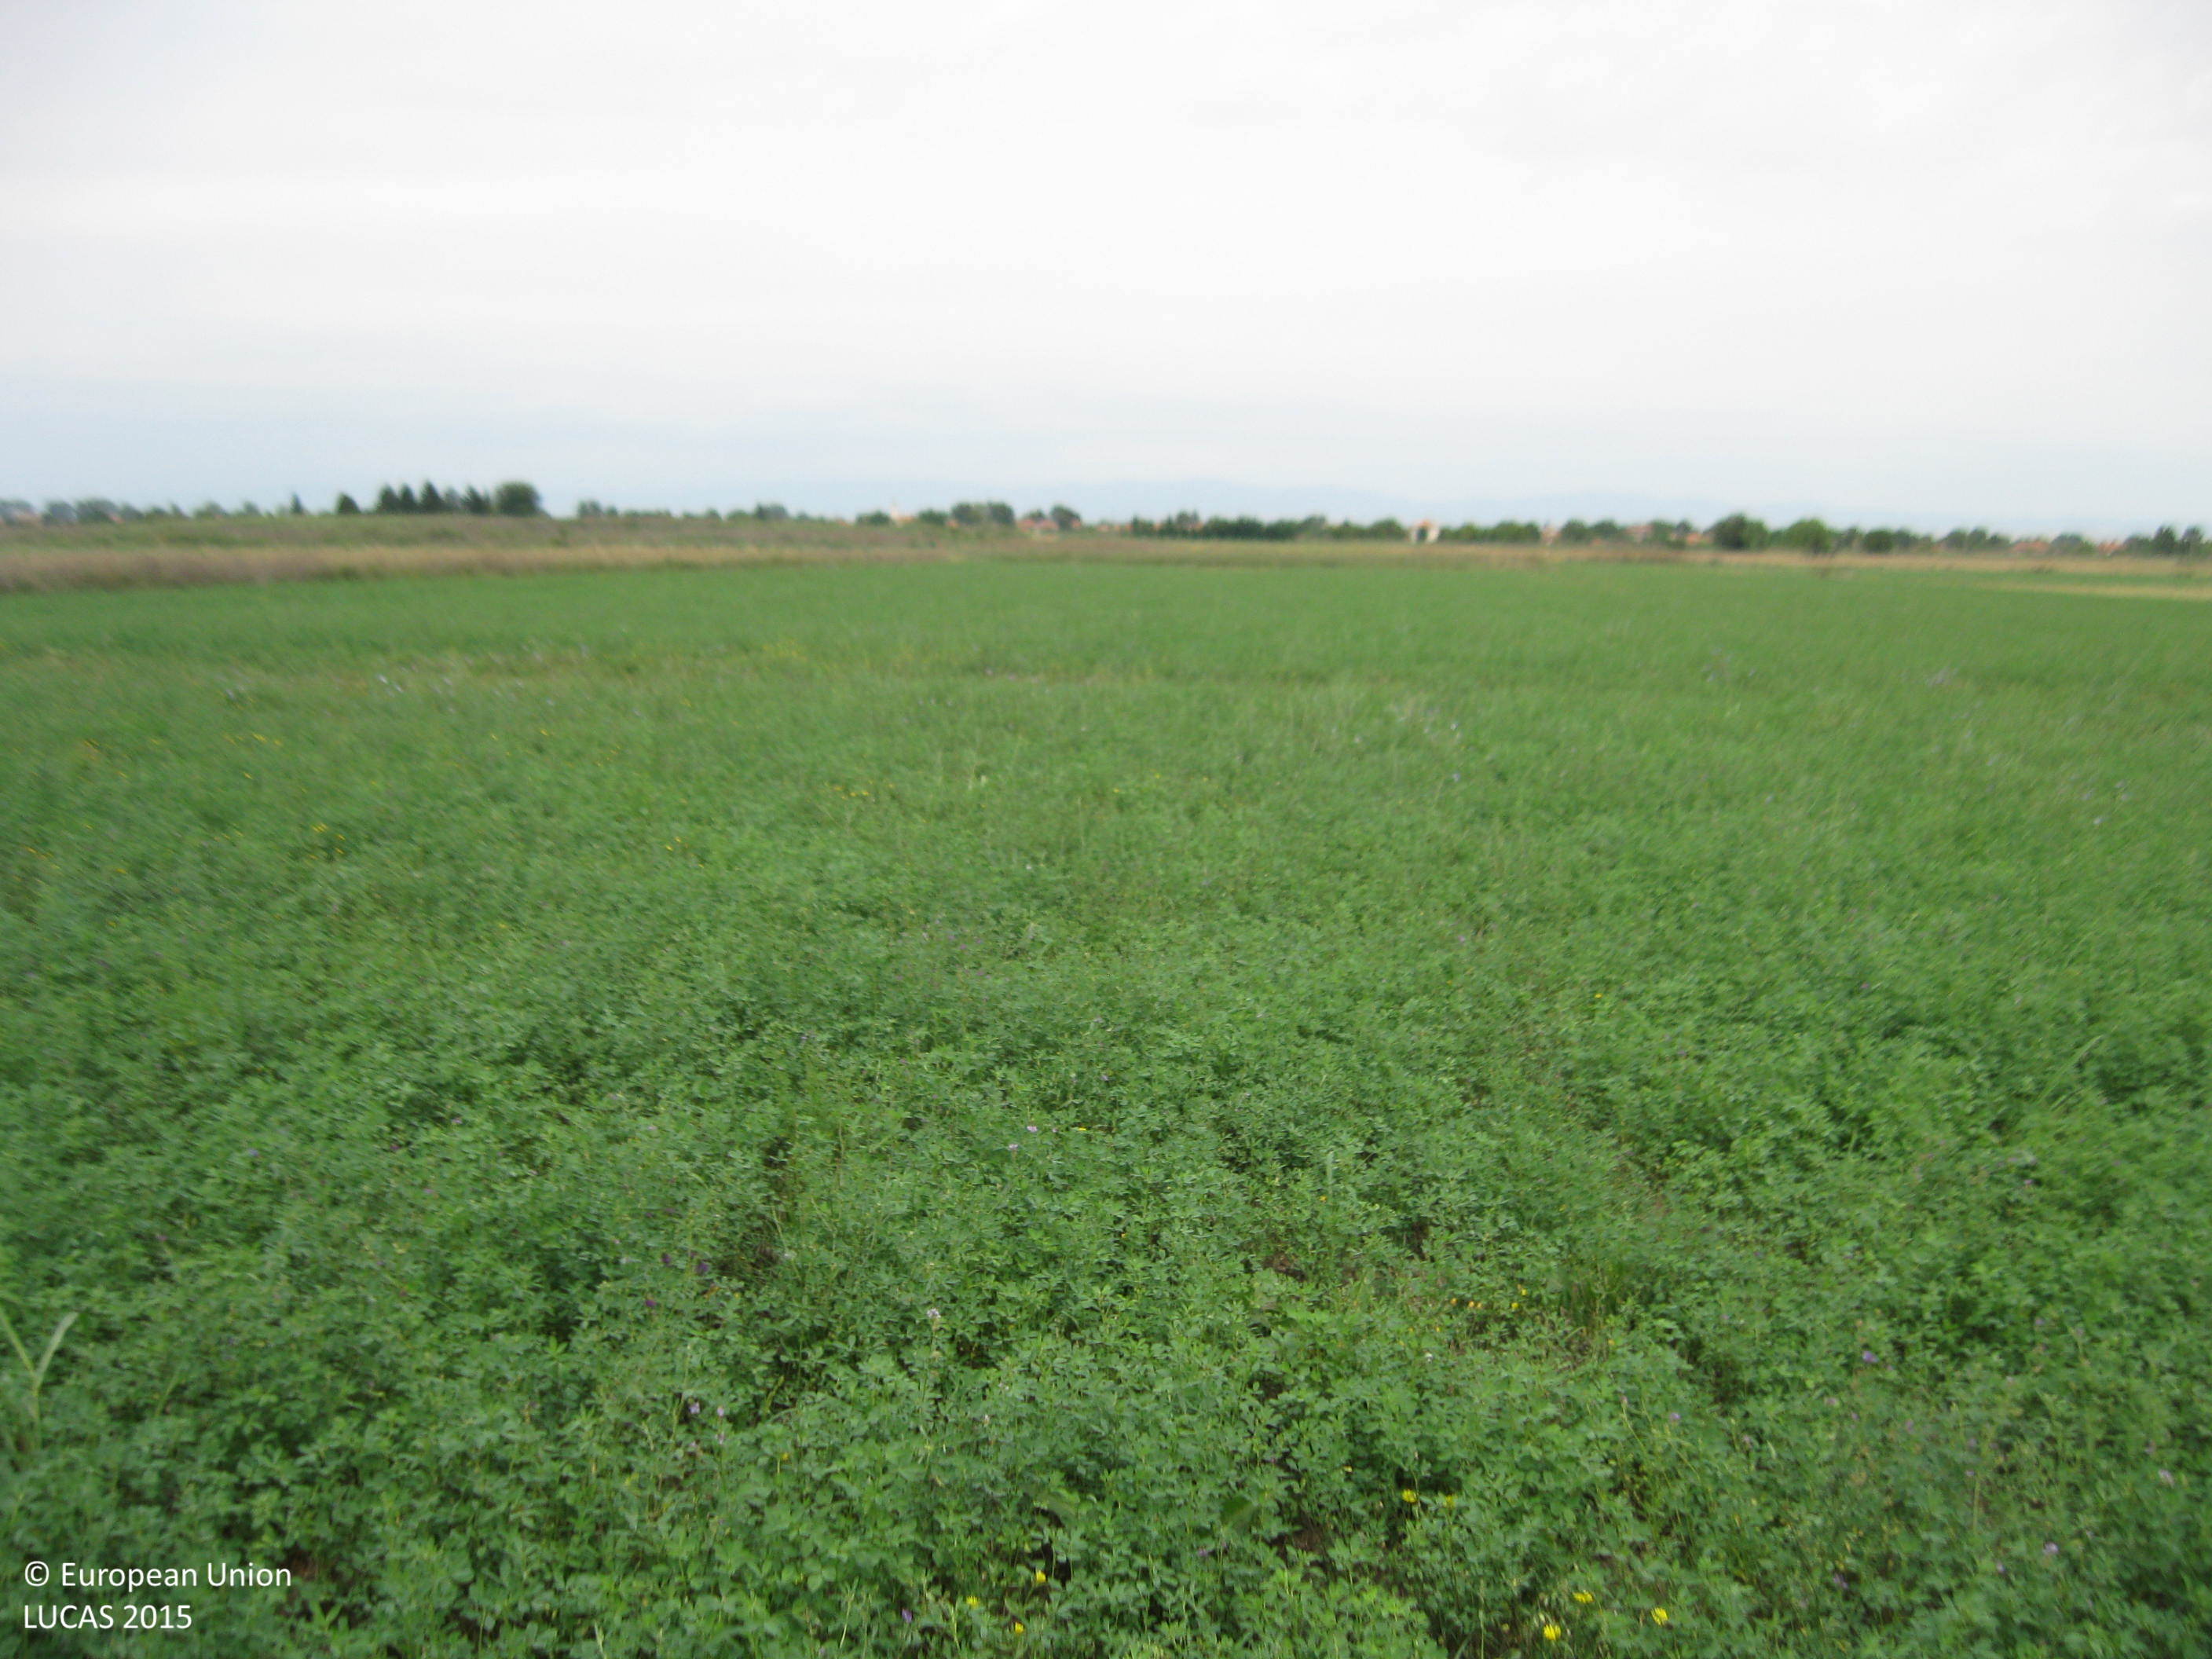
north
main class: Cropland
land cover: Lucerne
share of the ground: > 75 %
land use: Agriculture (excluding fallow land and kitchen gardens)
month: September
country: BG
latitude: 42.1385
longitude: 25.0969
